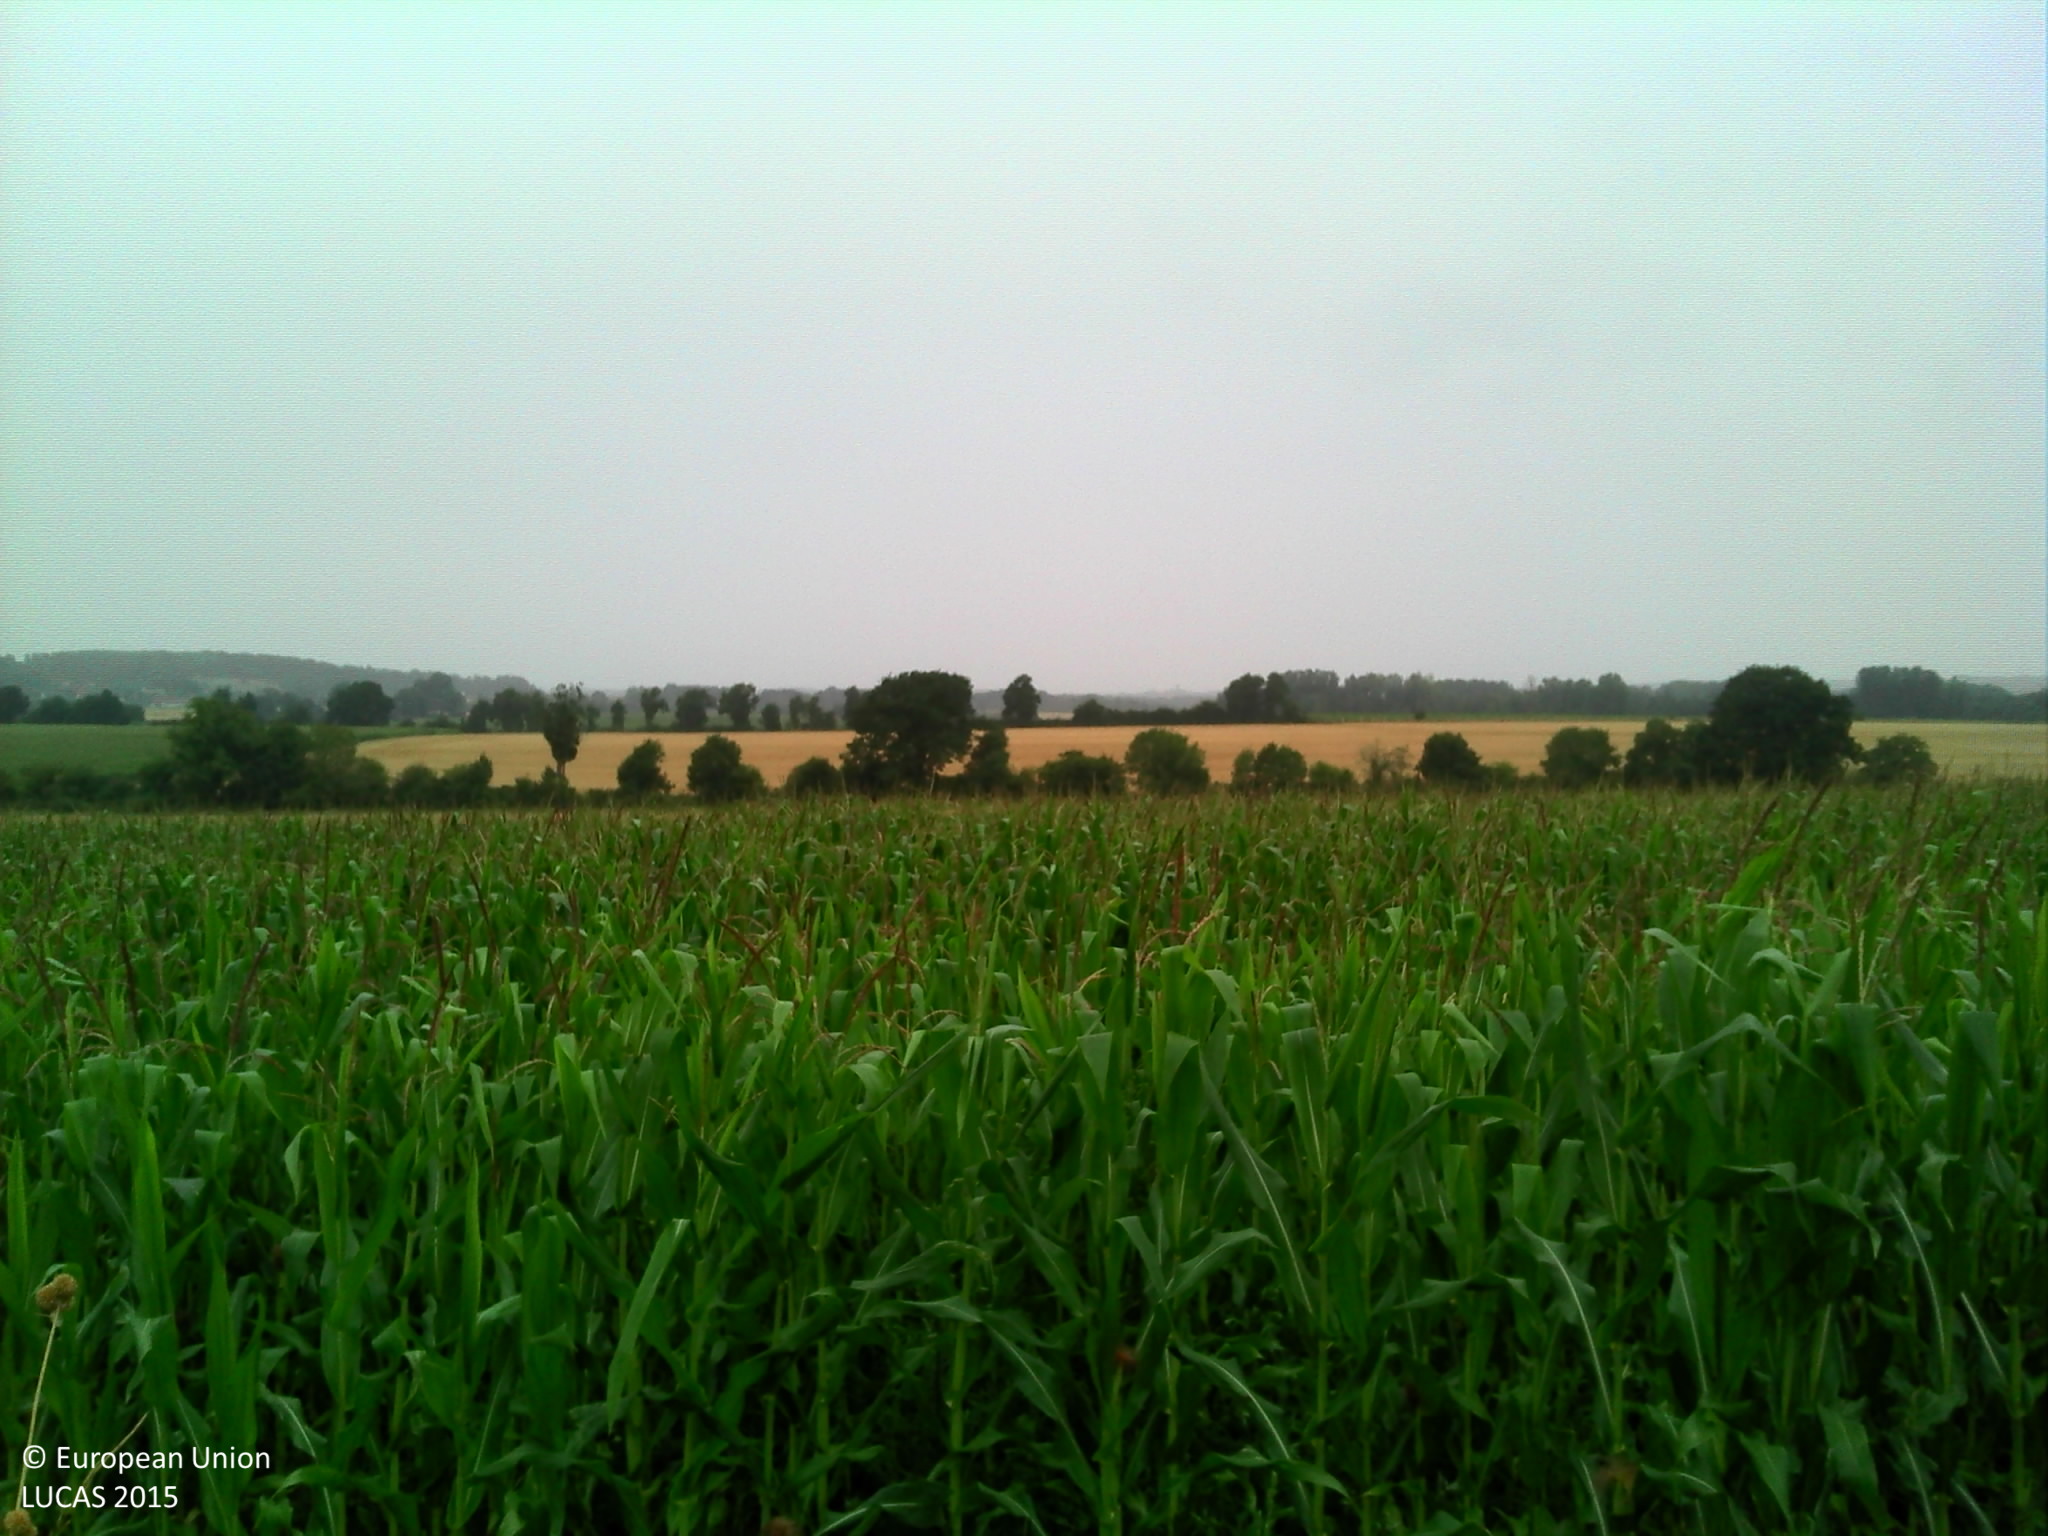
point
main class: Cropland
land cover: Maize
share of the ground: > 75 %
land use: Agriculture (excluding fallow land and kitchen gardens)
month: July
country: FR
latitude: 48.0053
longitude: 0.6353
